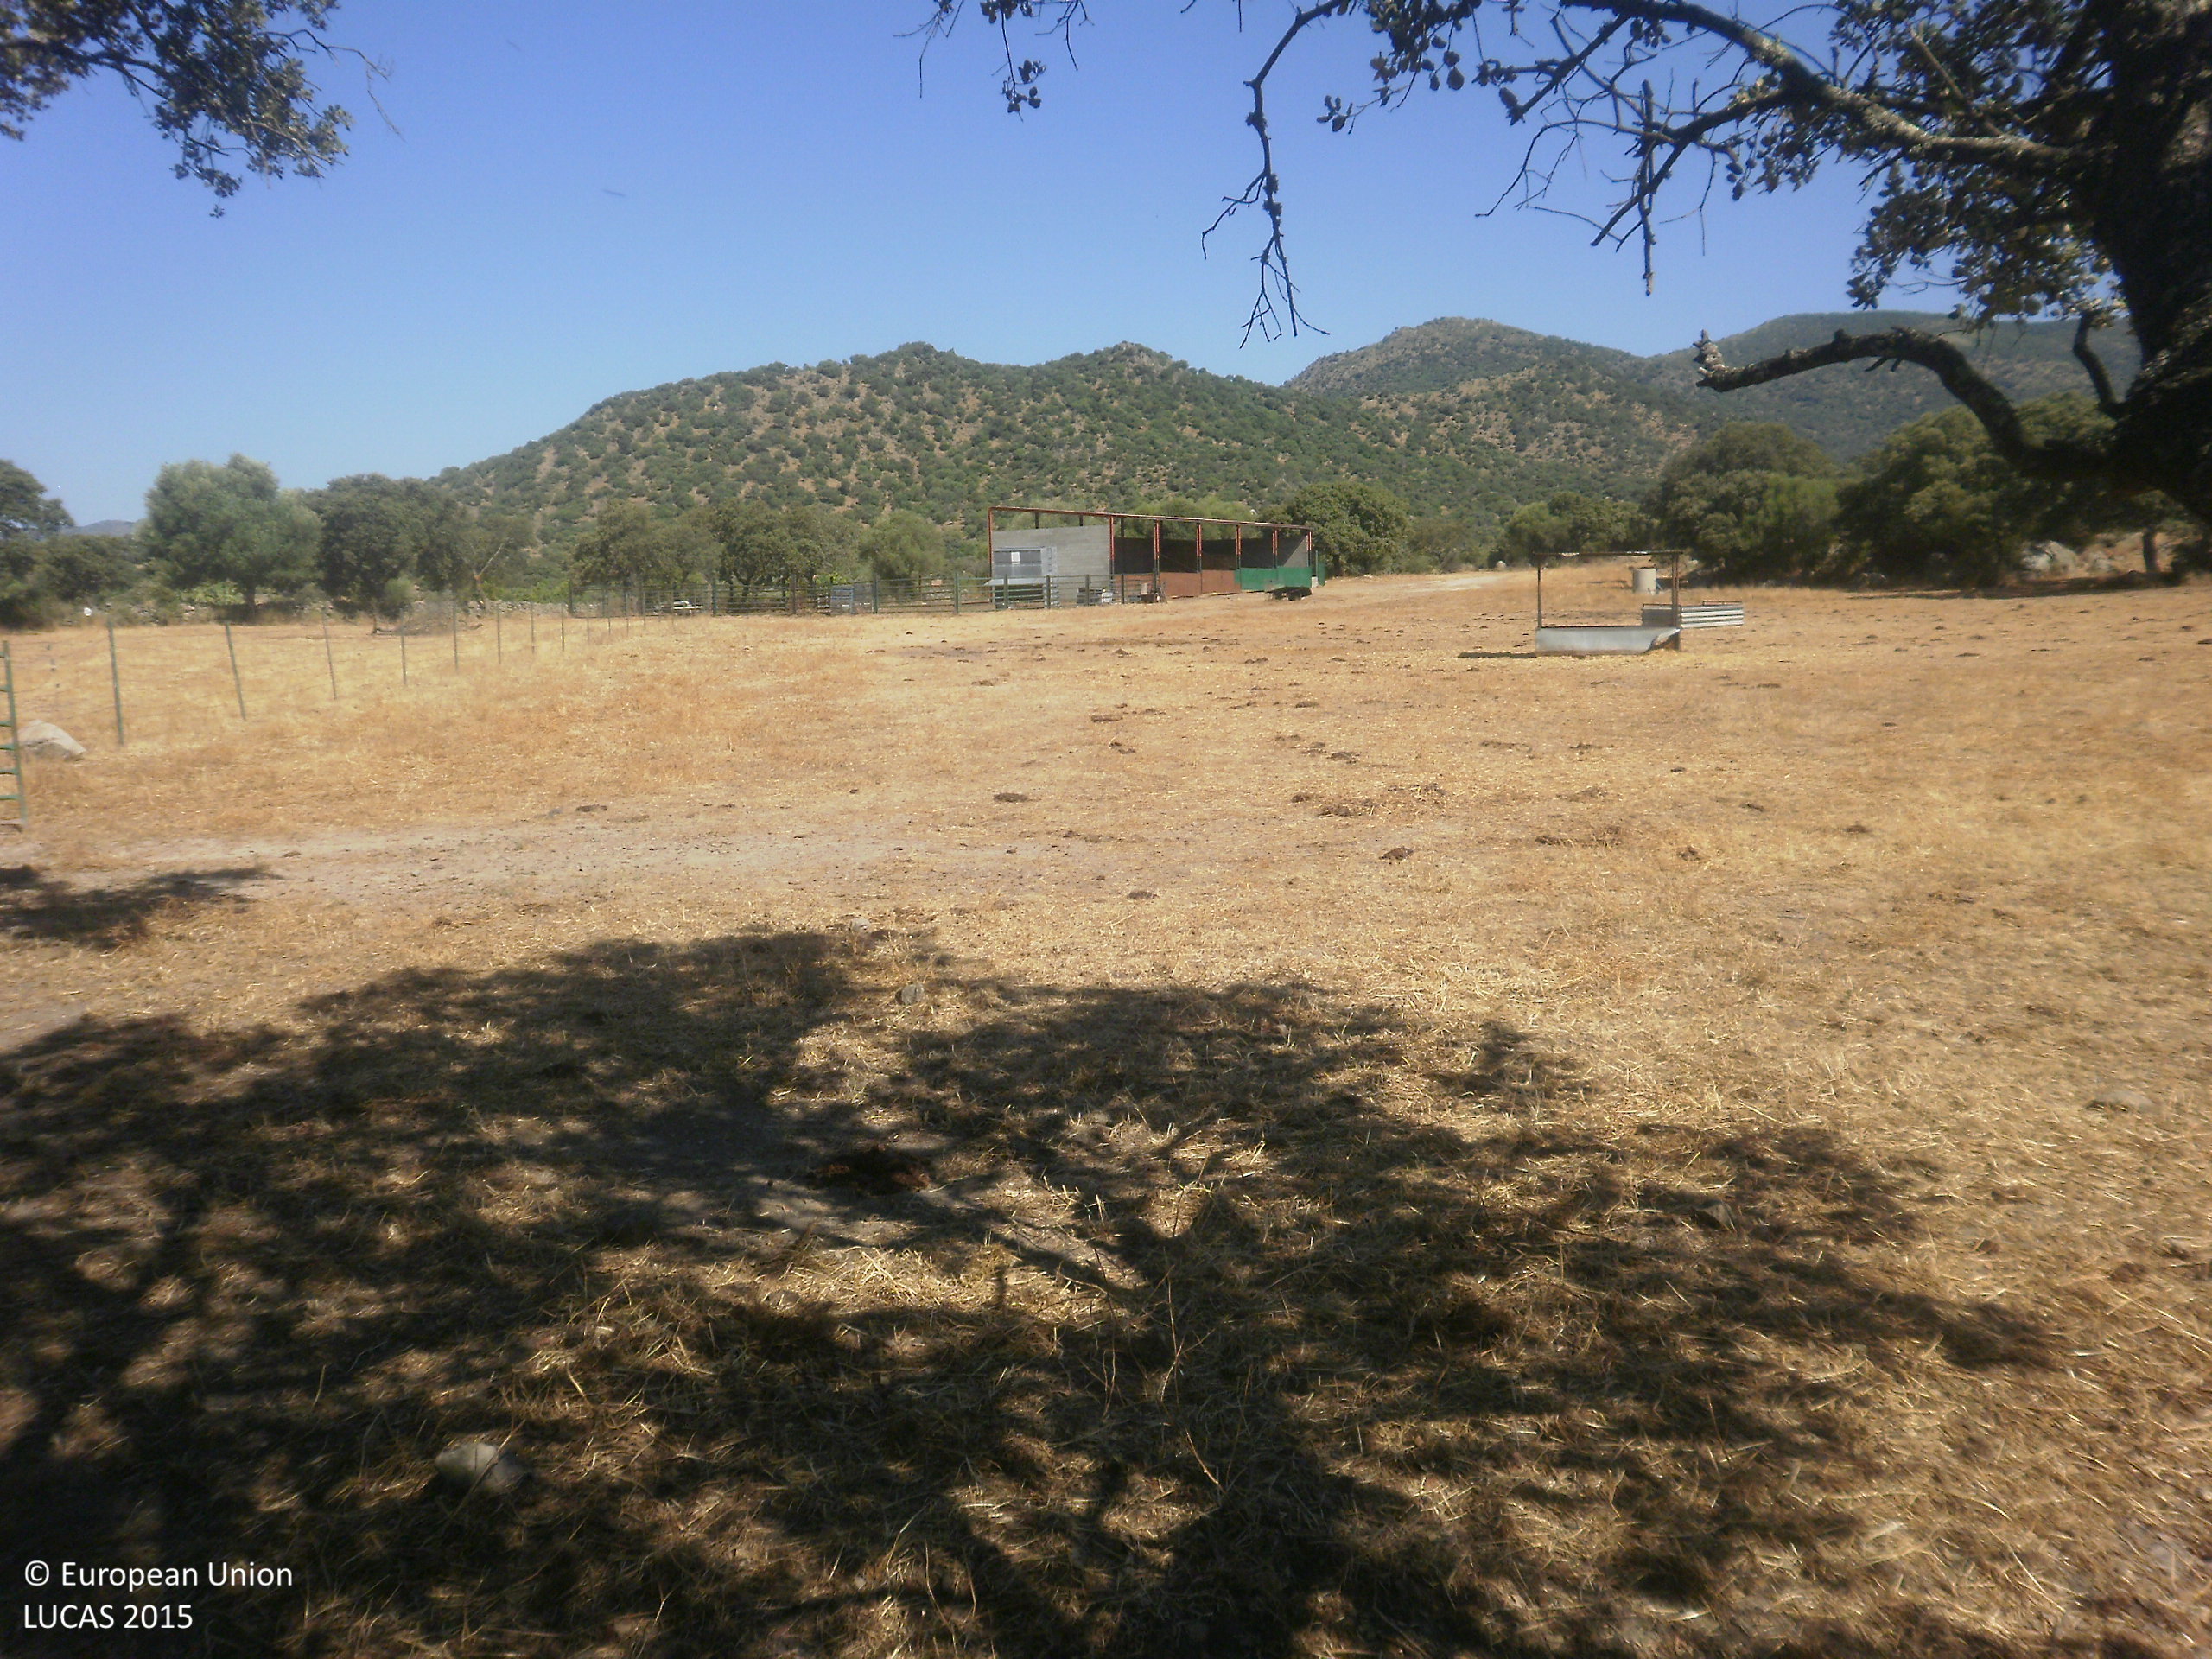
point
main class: Grassland
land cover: Grassland without tree/shrub cover
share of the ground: > 75 %
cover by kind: herbaceous plants 100 %
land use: Agriculture (excluding fallow land and kitchen gardens)
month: June
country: ES
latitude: 39.1806
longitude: -6.0196
